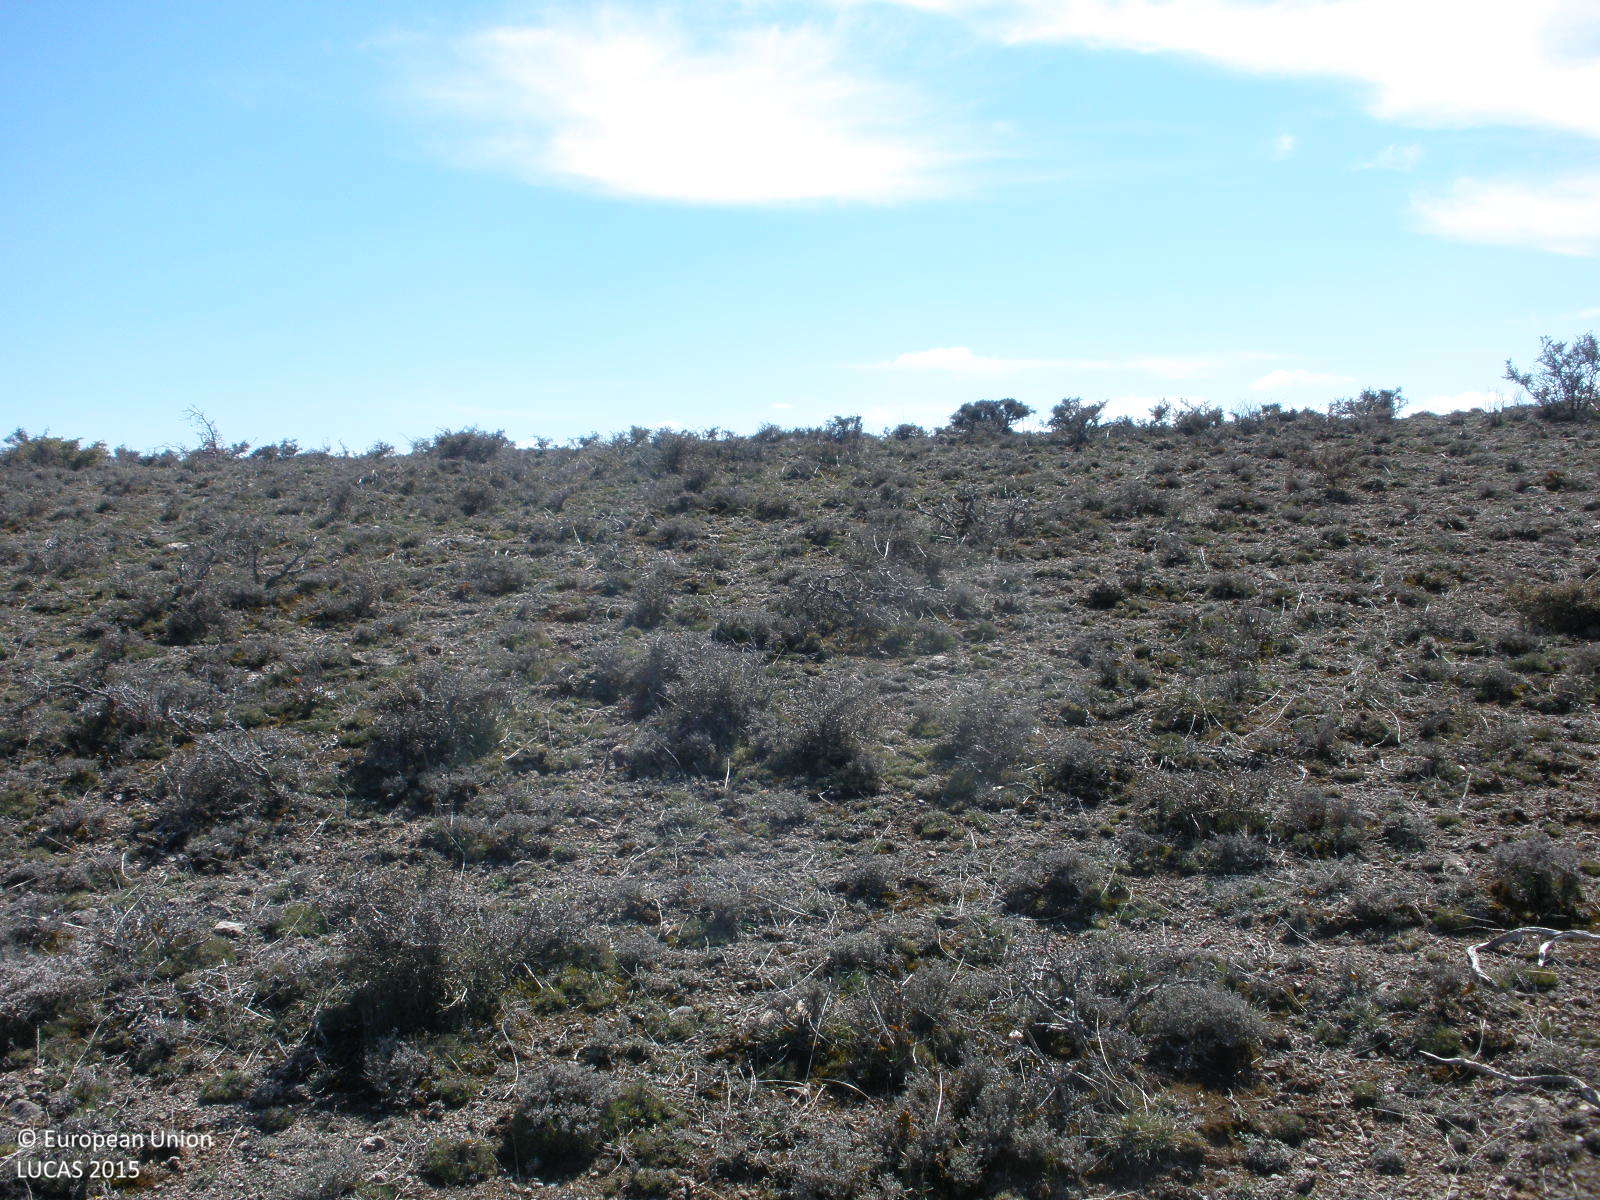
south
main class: Shrubland
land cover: Shrubland without tree cover
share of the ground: 50 - 75 %
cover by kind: shrubs 70 %, consolidated bare surface 30 %
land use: Semi-natural and natural areas not in use
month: April
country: ES
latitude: 40.9818
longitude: -1.1300
